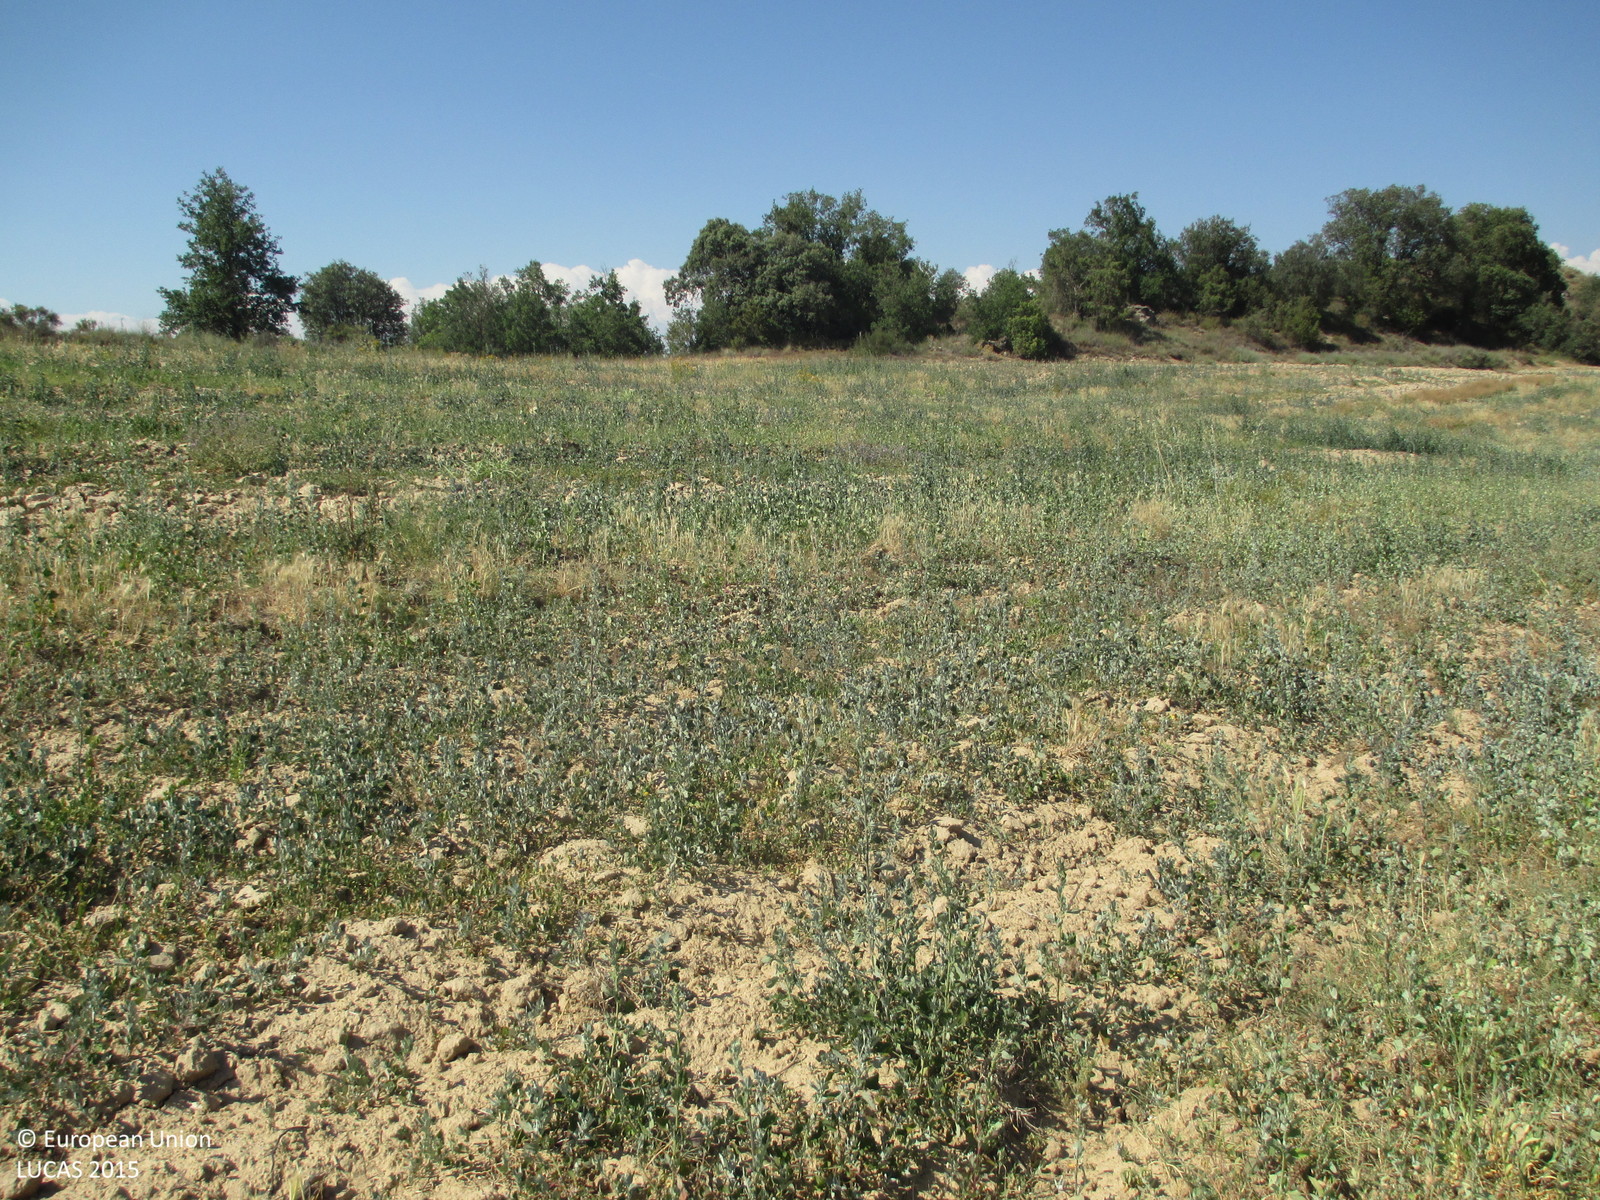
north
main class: Grassland
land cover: Spontaneously vegetated surfaces
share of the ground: 50 - 75 %
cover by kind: herbaceous plants 70 %, unconsolidated bare surface 30 %
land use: Fallow land
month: June
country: ES
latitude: 42.0573
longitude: 0.0848
